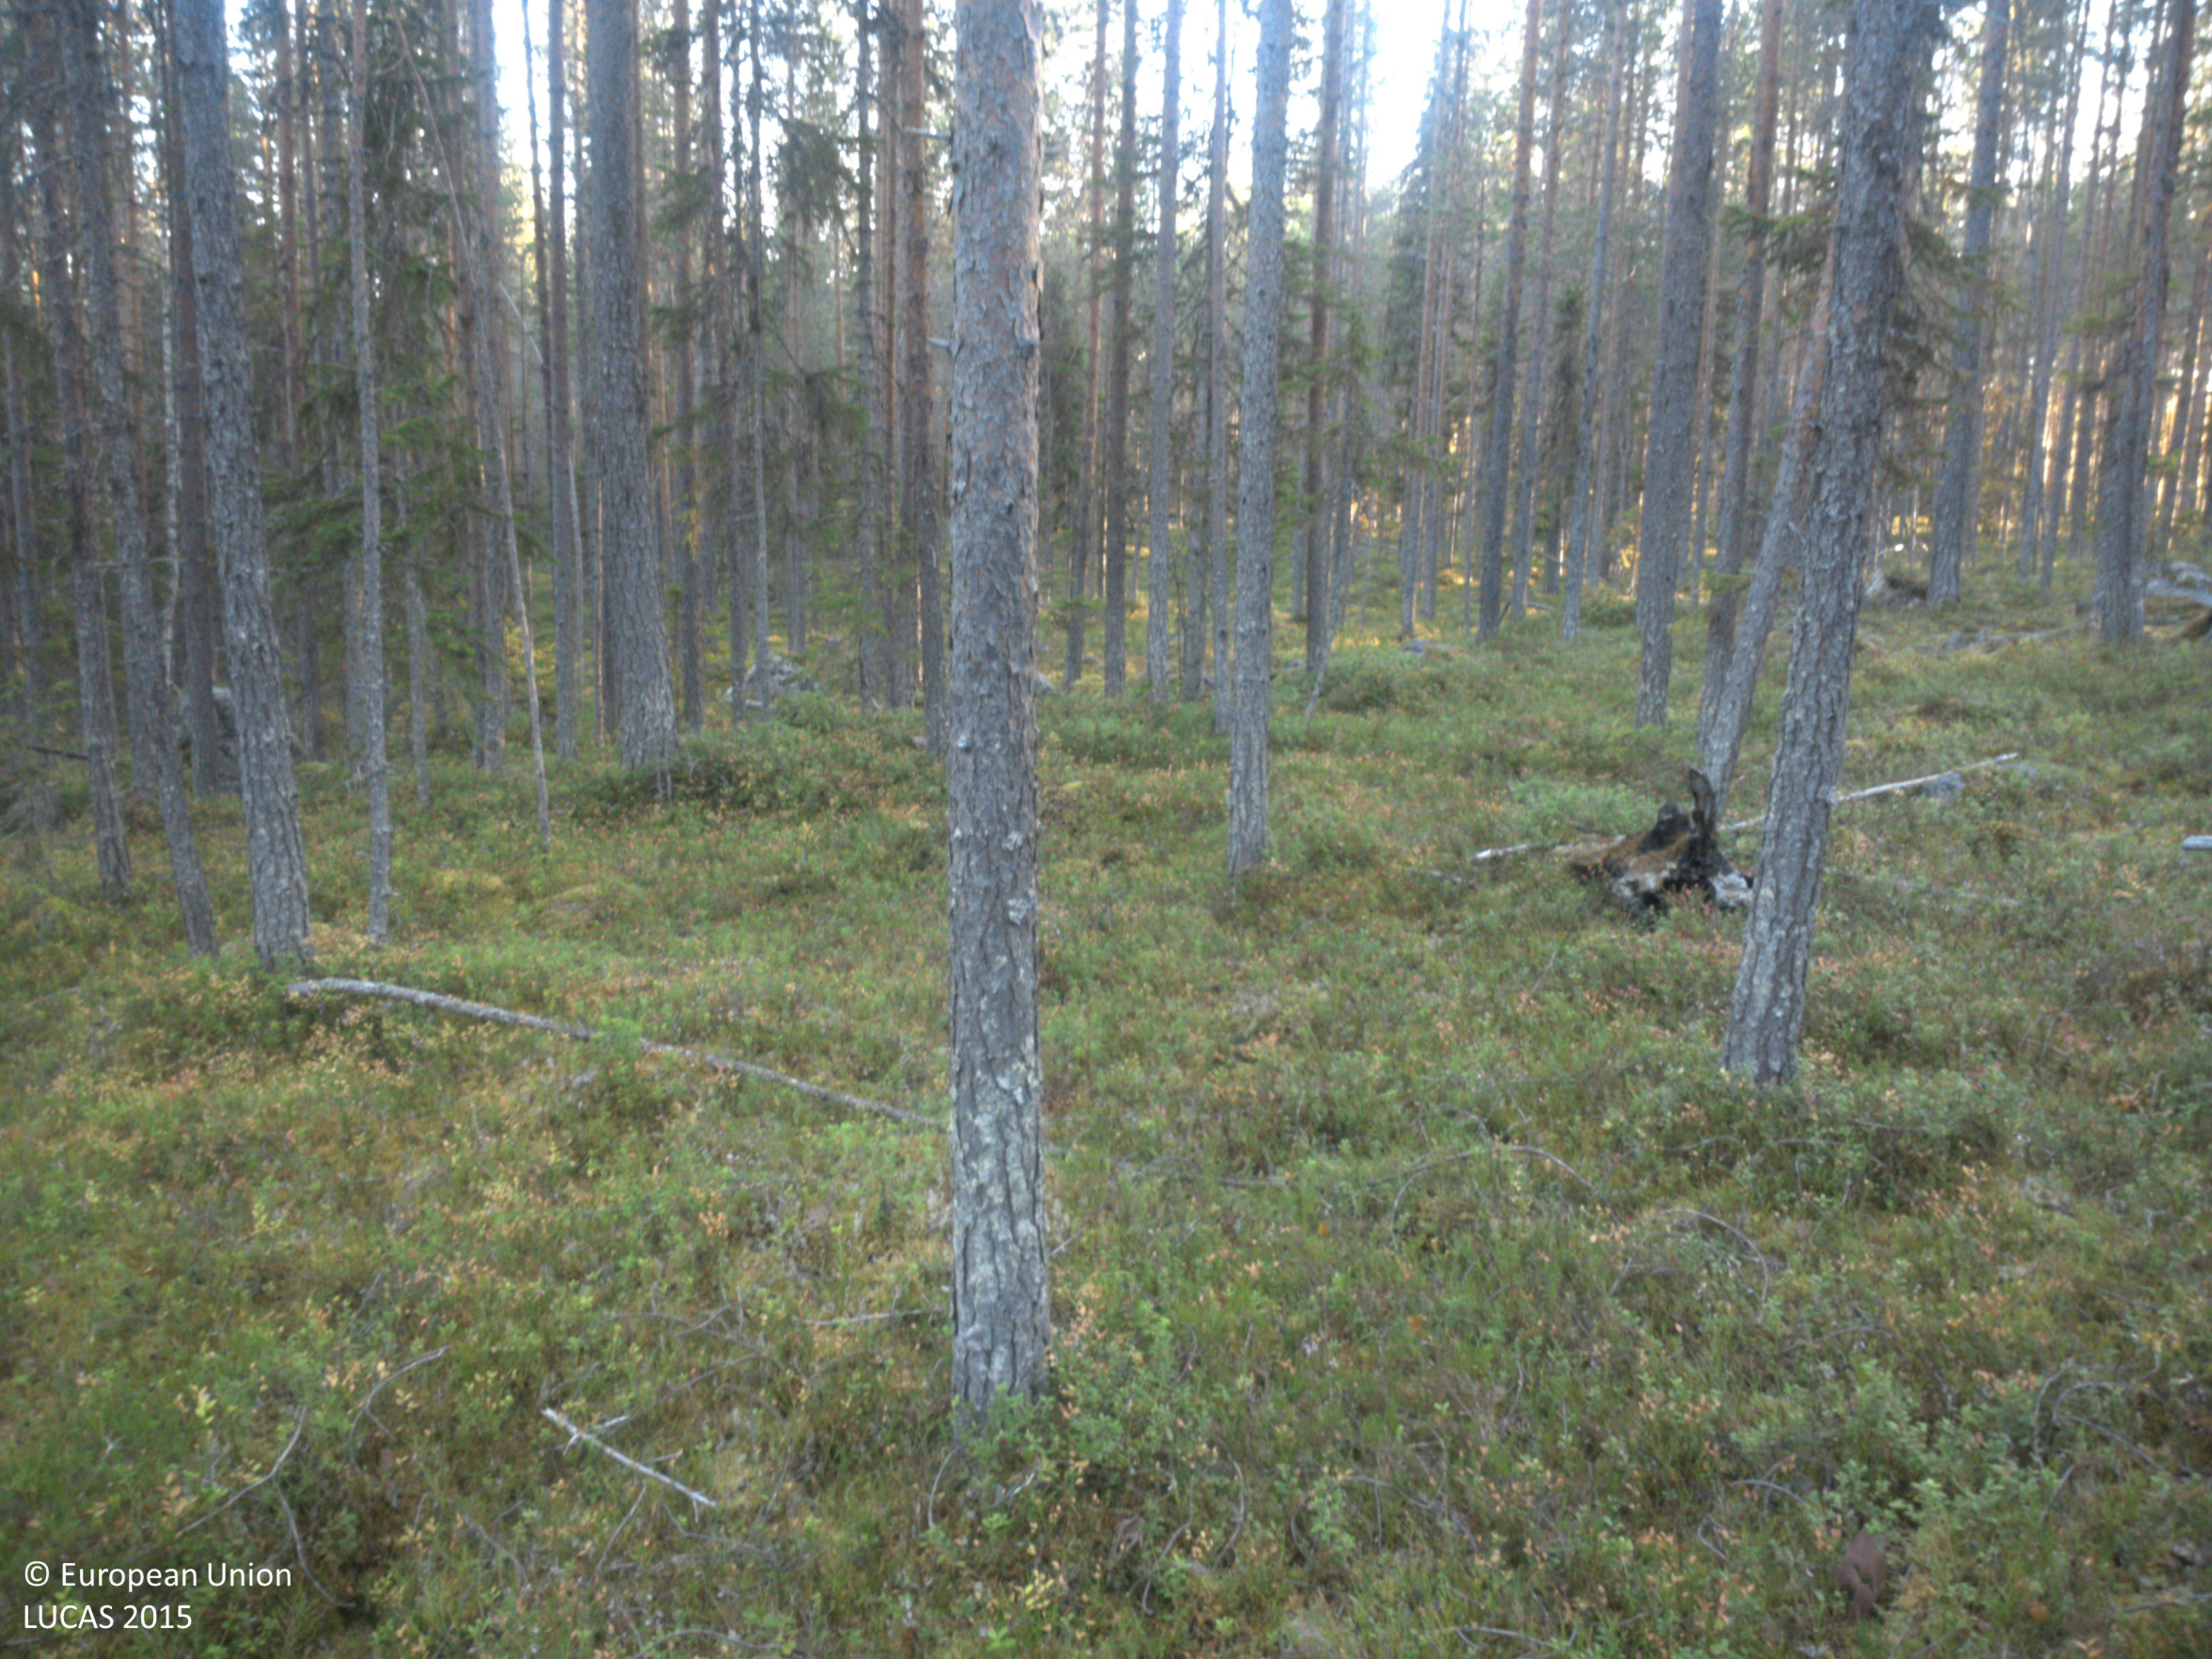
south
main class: Woodland
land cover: Pine dominated coniferous woodland
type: boreal forest
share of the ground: 50 - 75 %
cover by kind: coniferous forest trees 70 %, shrubs 25 %, lichens and mosses 5 %
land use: Forestry
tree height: > 5 m
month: October
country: SE
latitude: 64.8599
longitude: 18.1714
